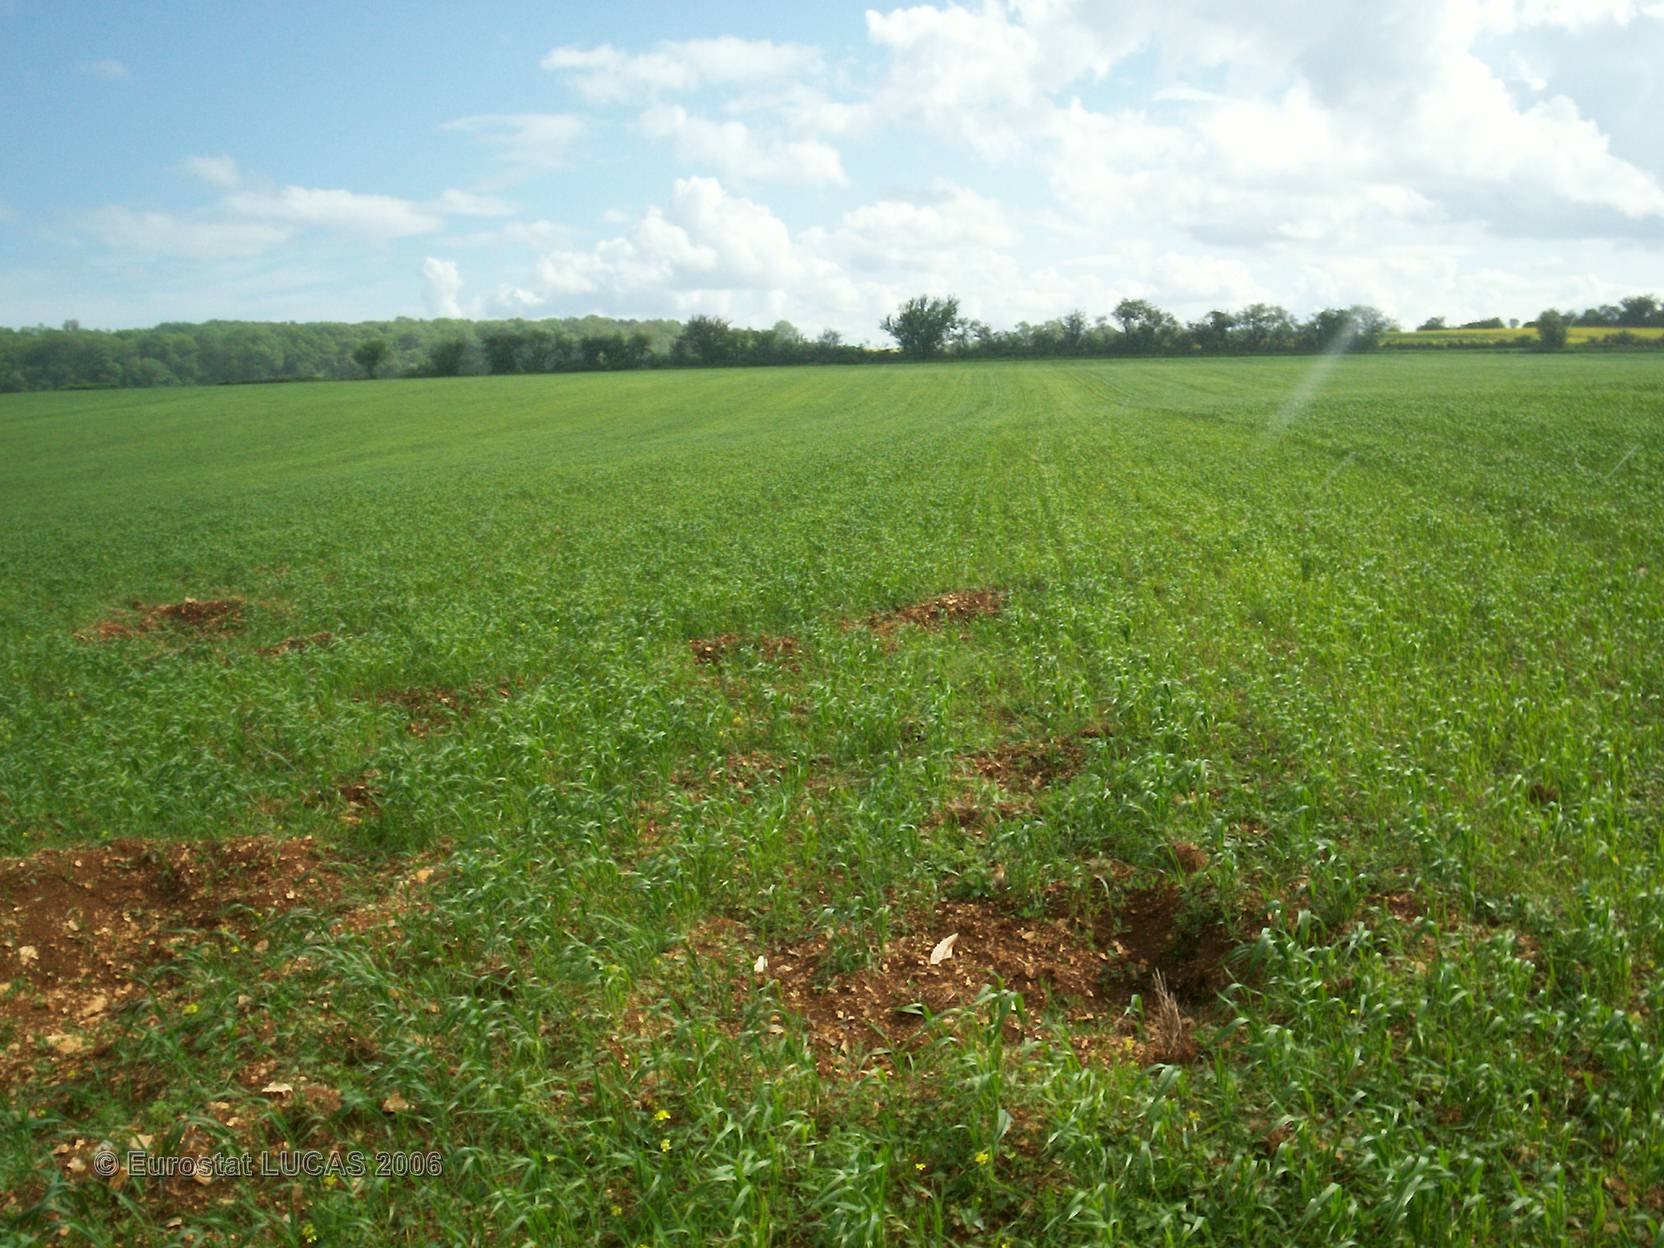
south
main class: Cropland
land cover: Barley
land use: Agriculture (excluding fallow land and kitchen gardens)
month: May
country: FR
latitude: 47.0125
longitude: 4.6730
